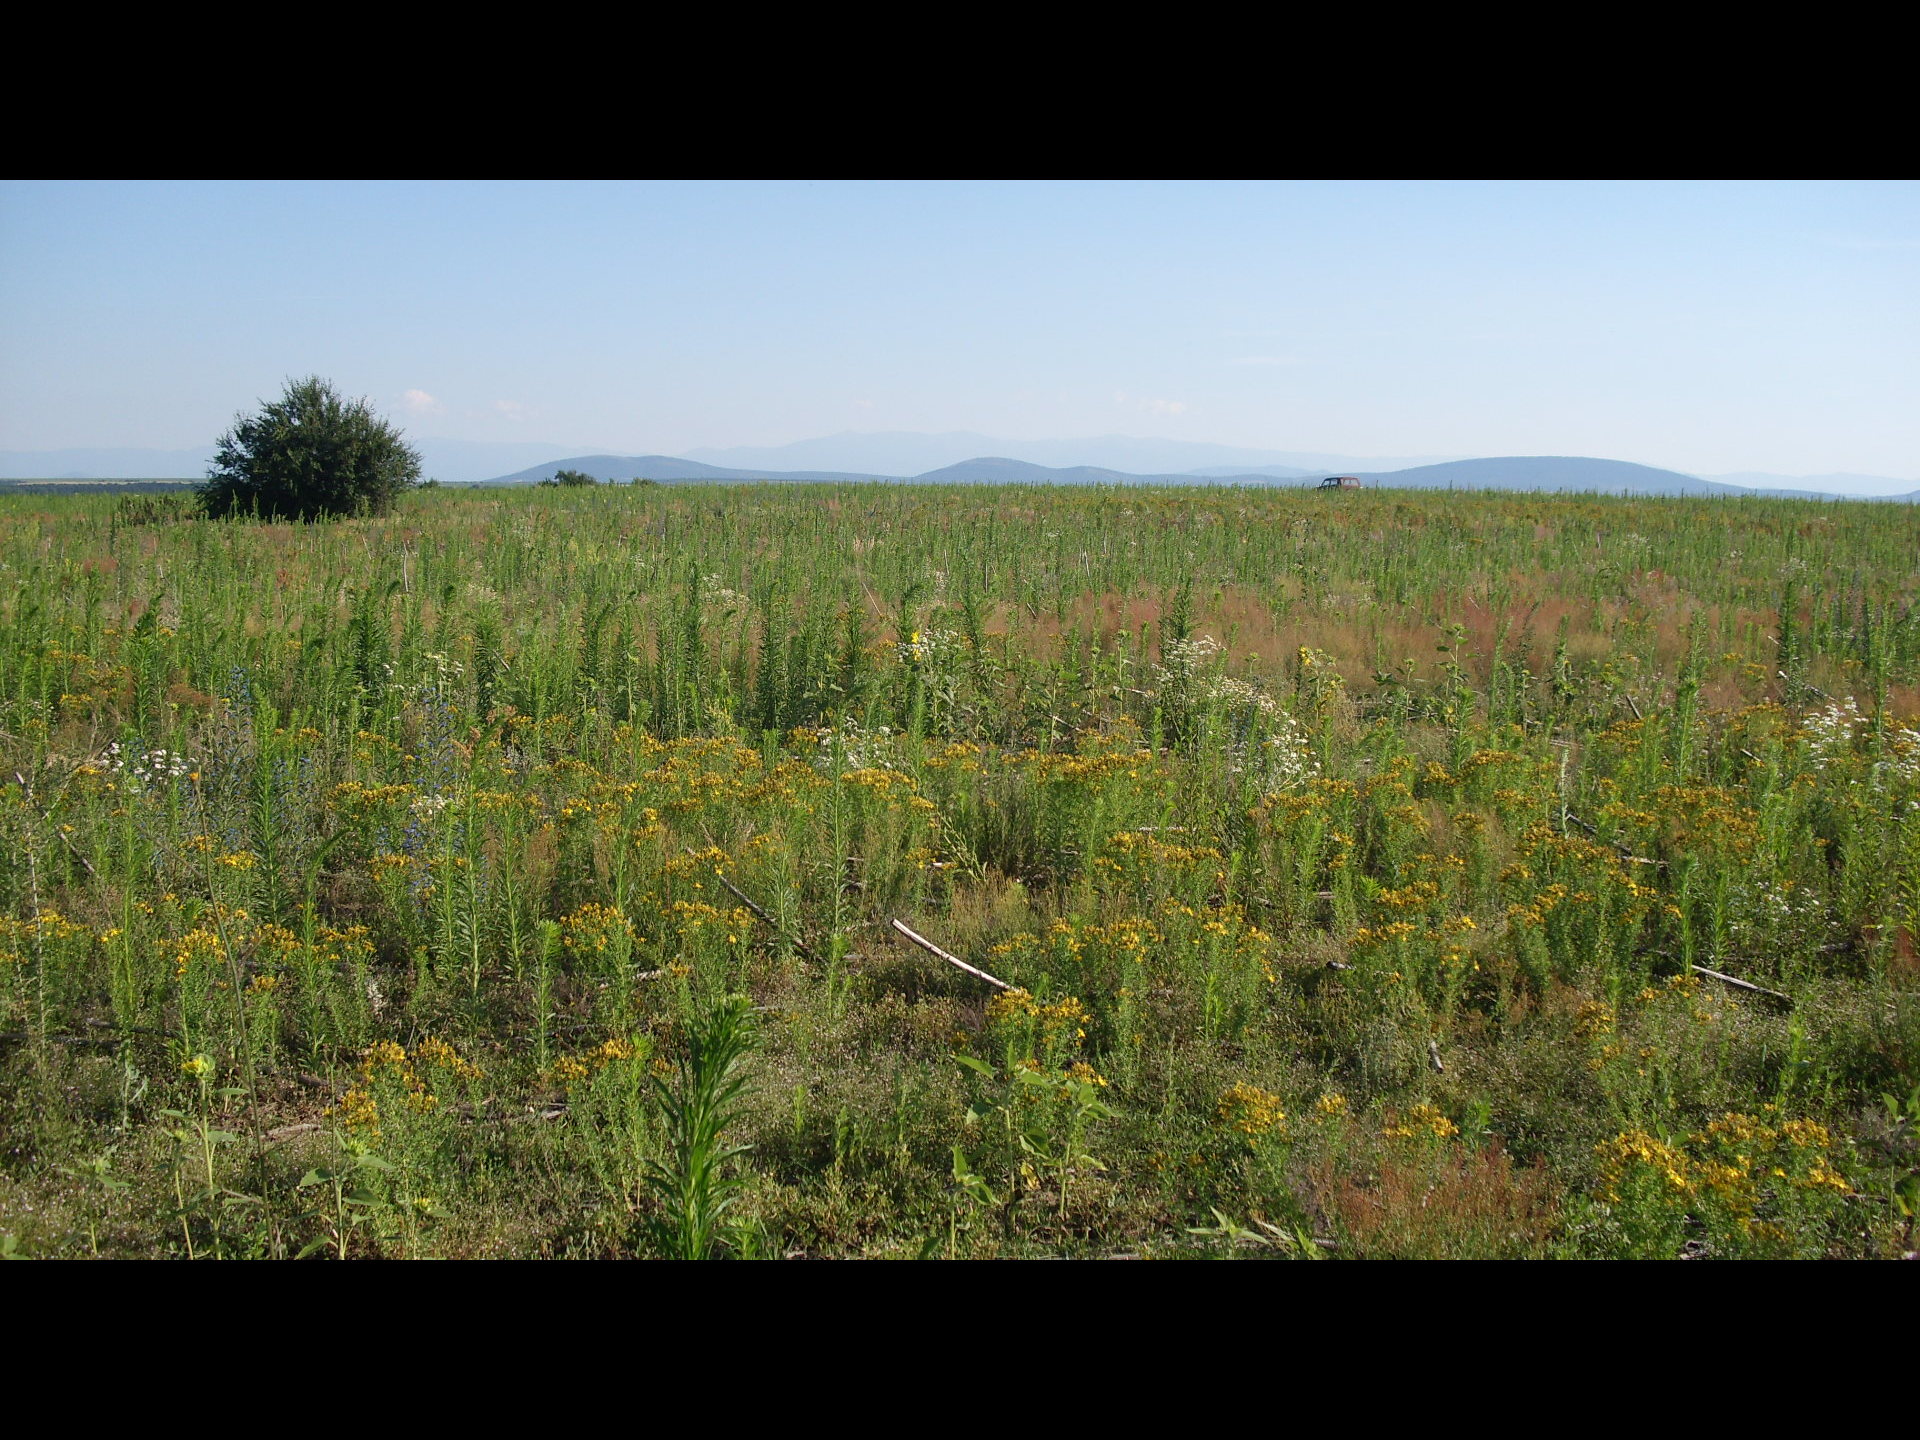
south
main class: Grassland
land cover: Spontaneously vegetated surfaces
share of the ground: > 75 %
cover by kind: herbaceous plants 85 %, unconsolidated bare surface 15 %
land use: Fallow land
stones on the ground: < 10 %
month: June
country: BG
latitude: 43.5642
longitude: 23.1510
